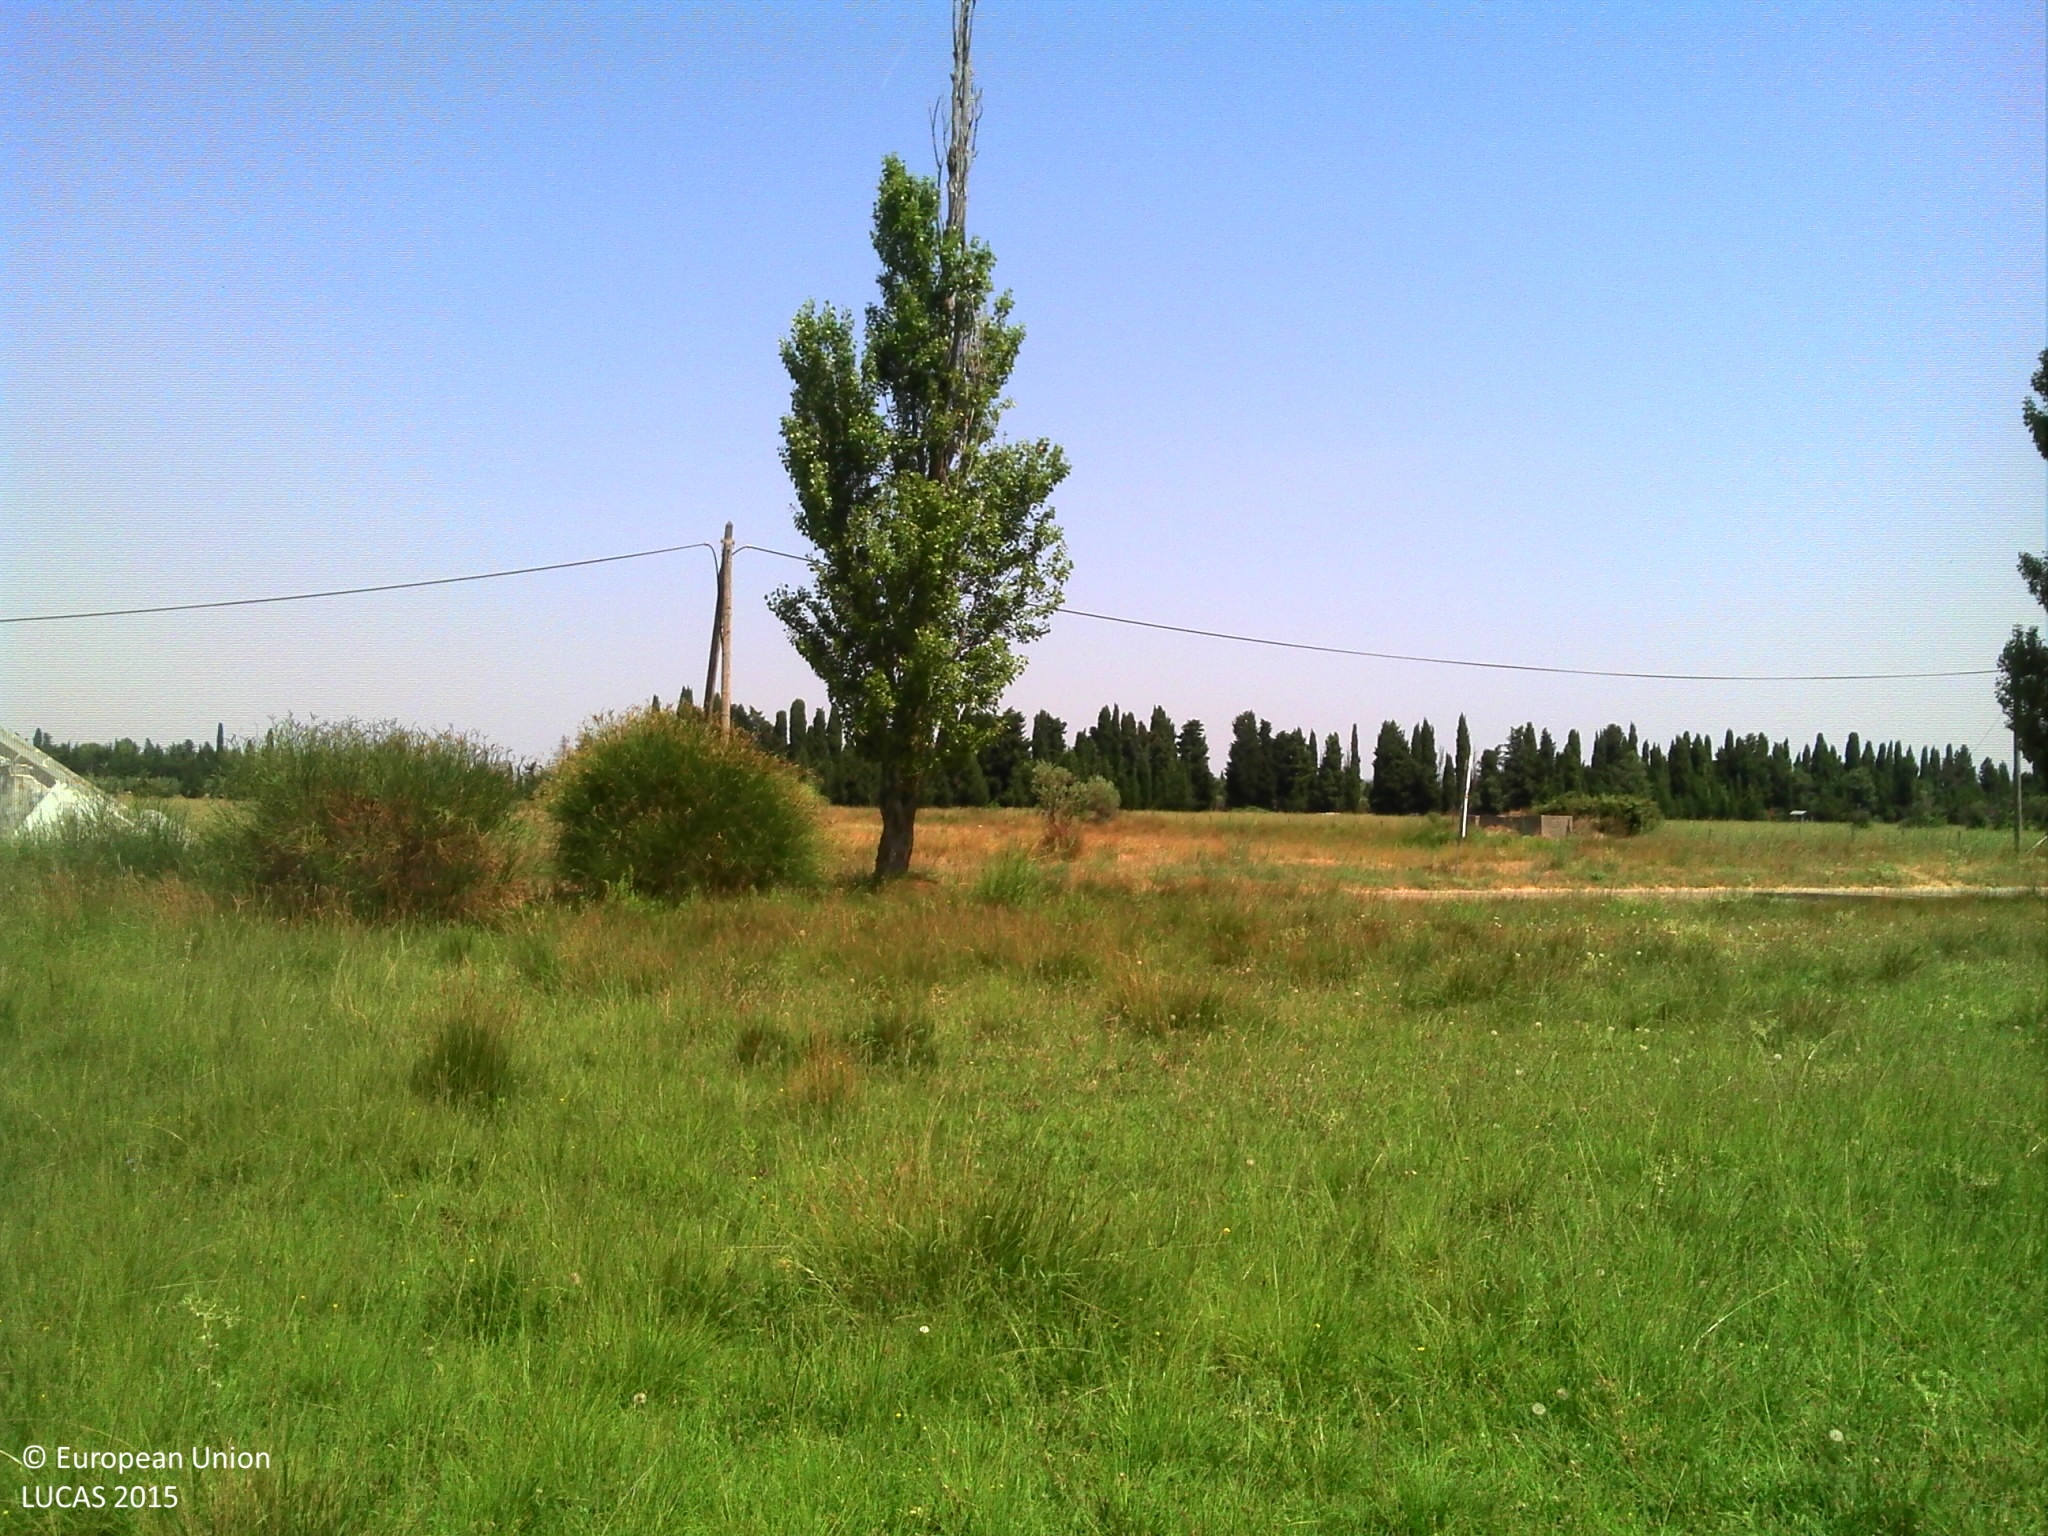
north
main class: Grassland
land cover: Grassland without tree/shrub cover
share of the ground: > 75 %
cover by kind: herbaceous plants 100 %
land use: Agriculture (excluding fallow land and kitchen gardens)
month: July
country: FR
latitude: 43.6723
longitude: 4.6886
